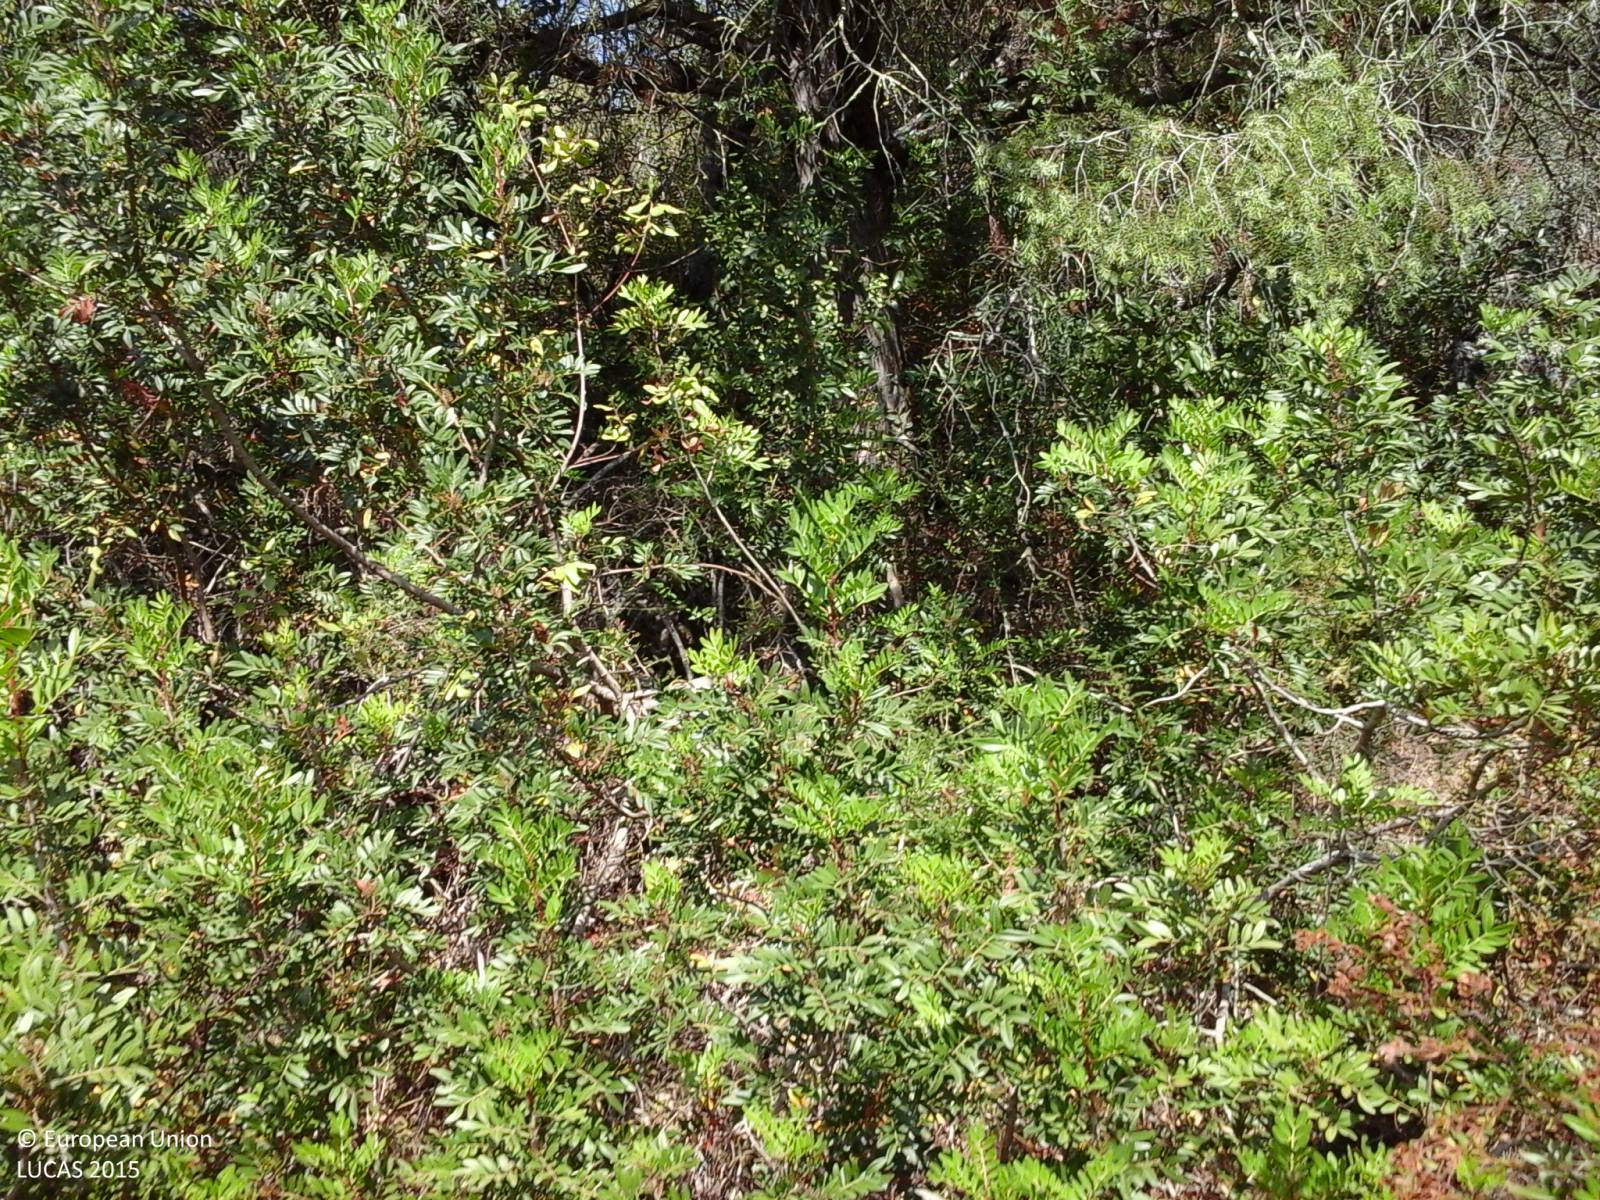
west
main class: Woodland
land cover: Broadleaved woodland
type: broadleaved evergreen forest
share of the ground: > 75 %
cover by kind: herbaceous plants 60 %, shrubs 30 %, broadleaved forest trees 10 %
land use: Semi-natural and natural areas not in use
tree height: > 5 m
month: July
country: IT
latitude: 41.1334
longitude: 9.3003
